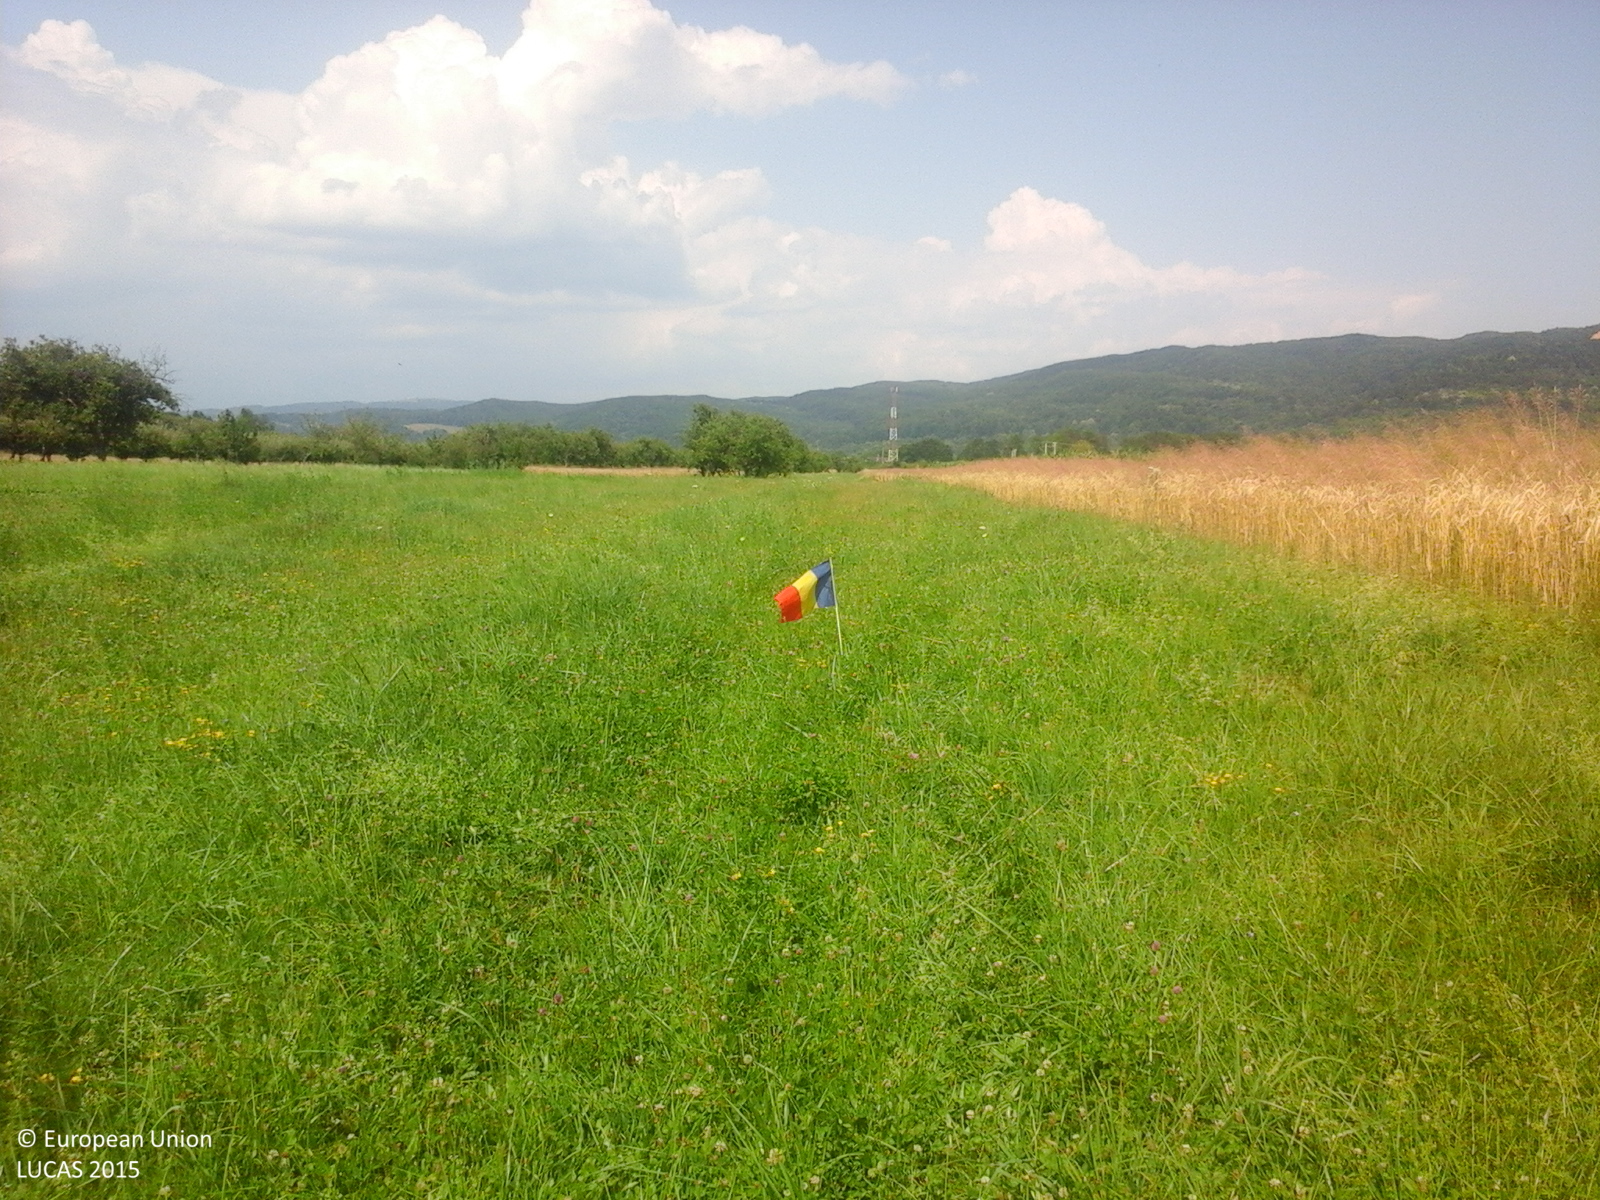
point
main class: Cropland
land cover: Lucerne
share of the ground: > 75 %
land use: Agriculture (excluding fallow land and kitchen gardens)
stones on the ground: < 10 %
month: July
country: RO
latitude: 45.1602
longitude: 24.9833
